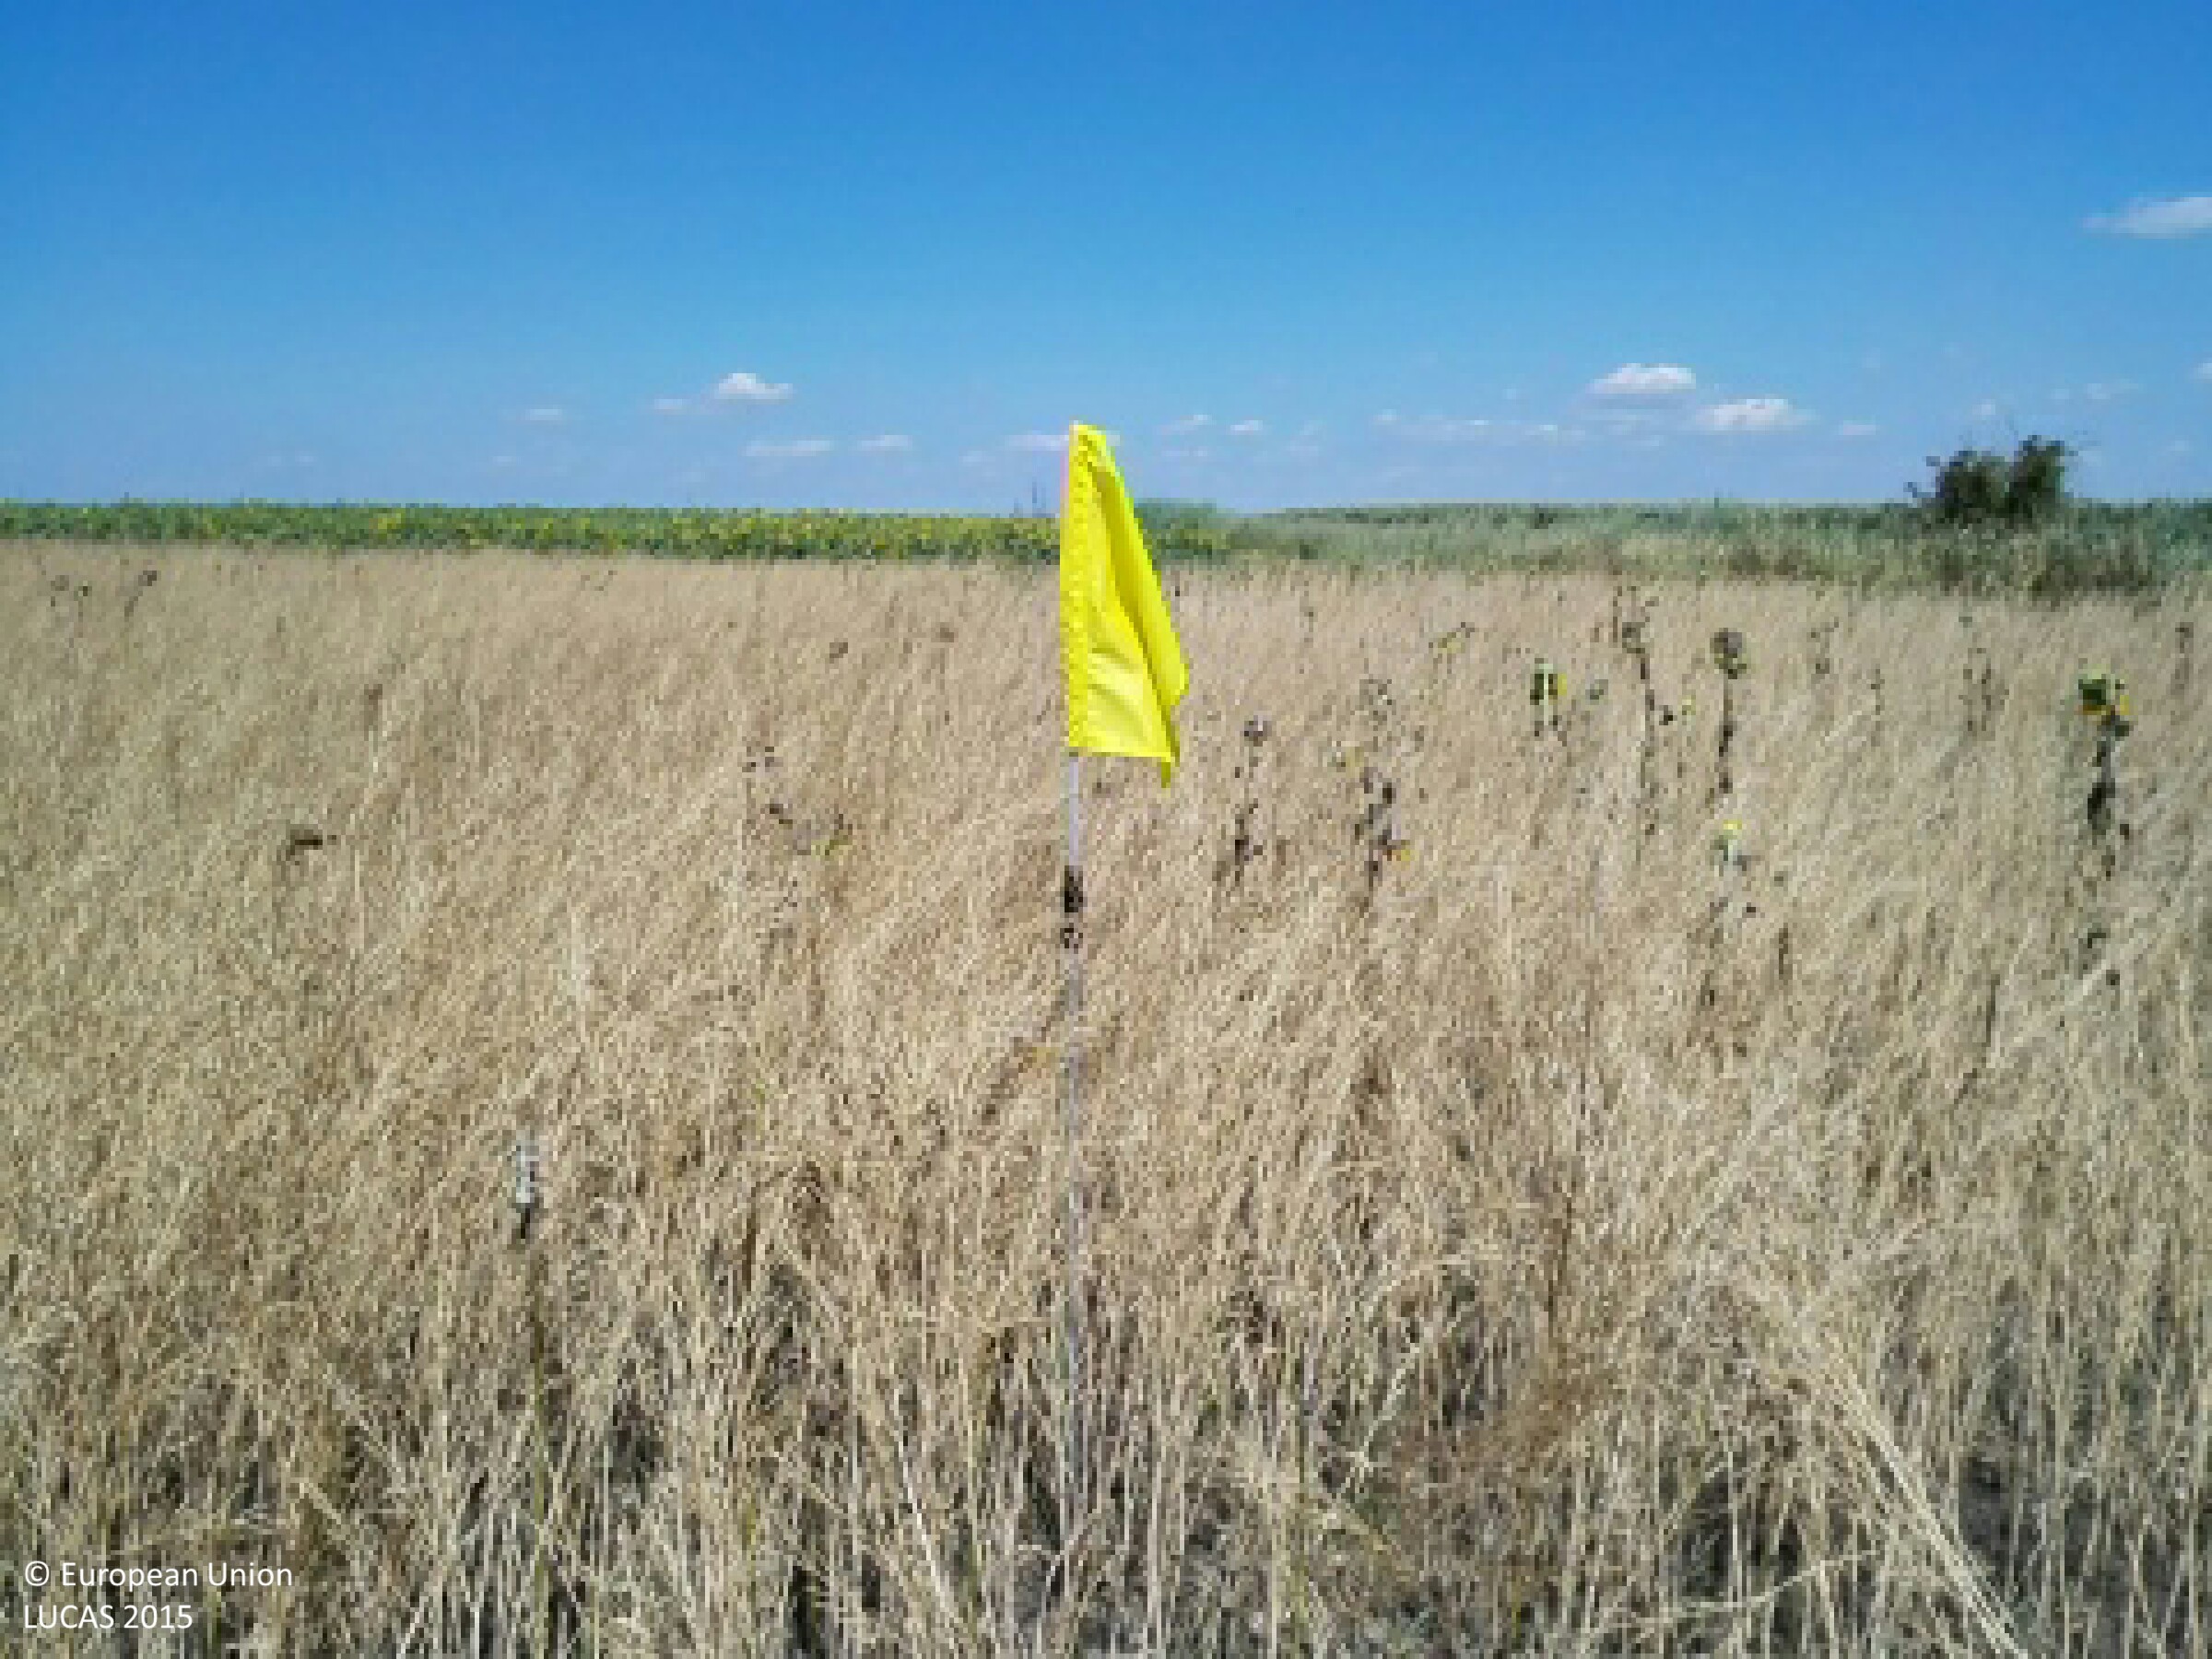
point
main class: Cropland
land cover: Rape and turnip rape
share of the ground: > 75 %
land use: Agriculture (excluding fallow land and kitchen gardens)
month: July
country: HU
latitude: 47.3848
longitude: 21.3125
